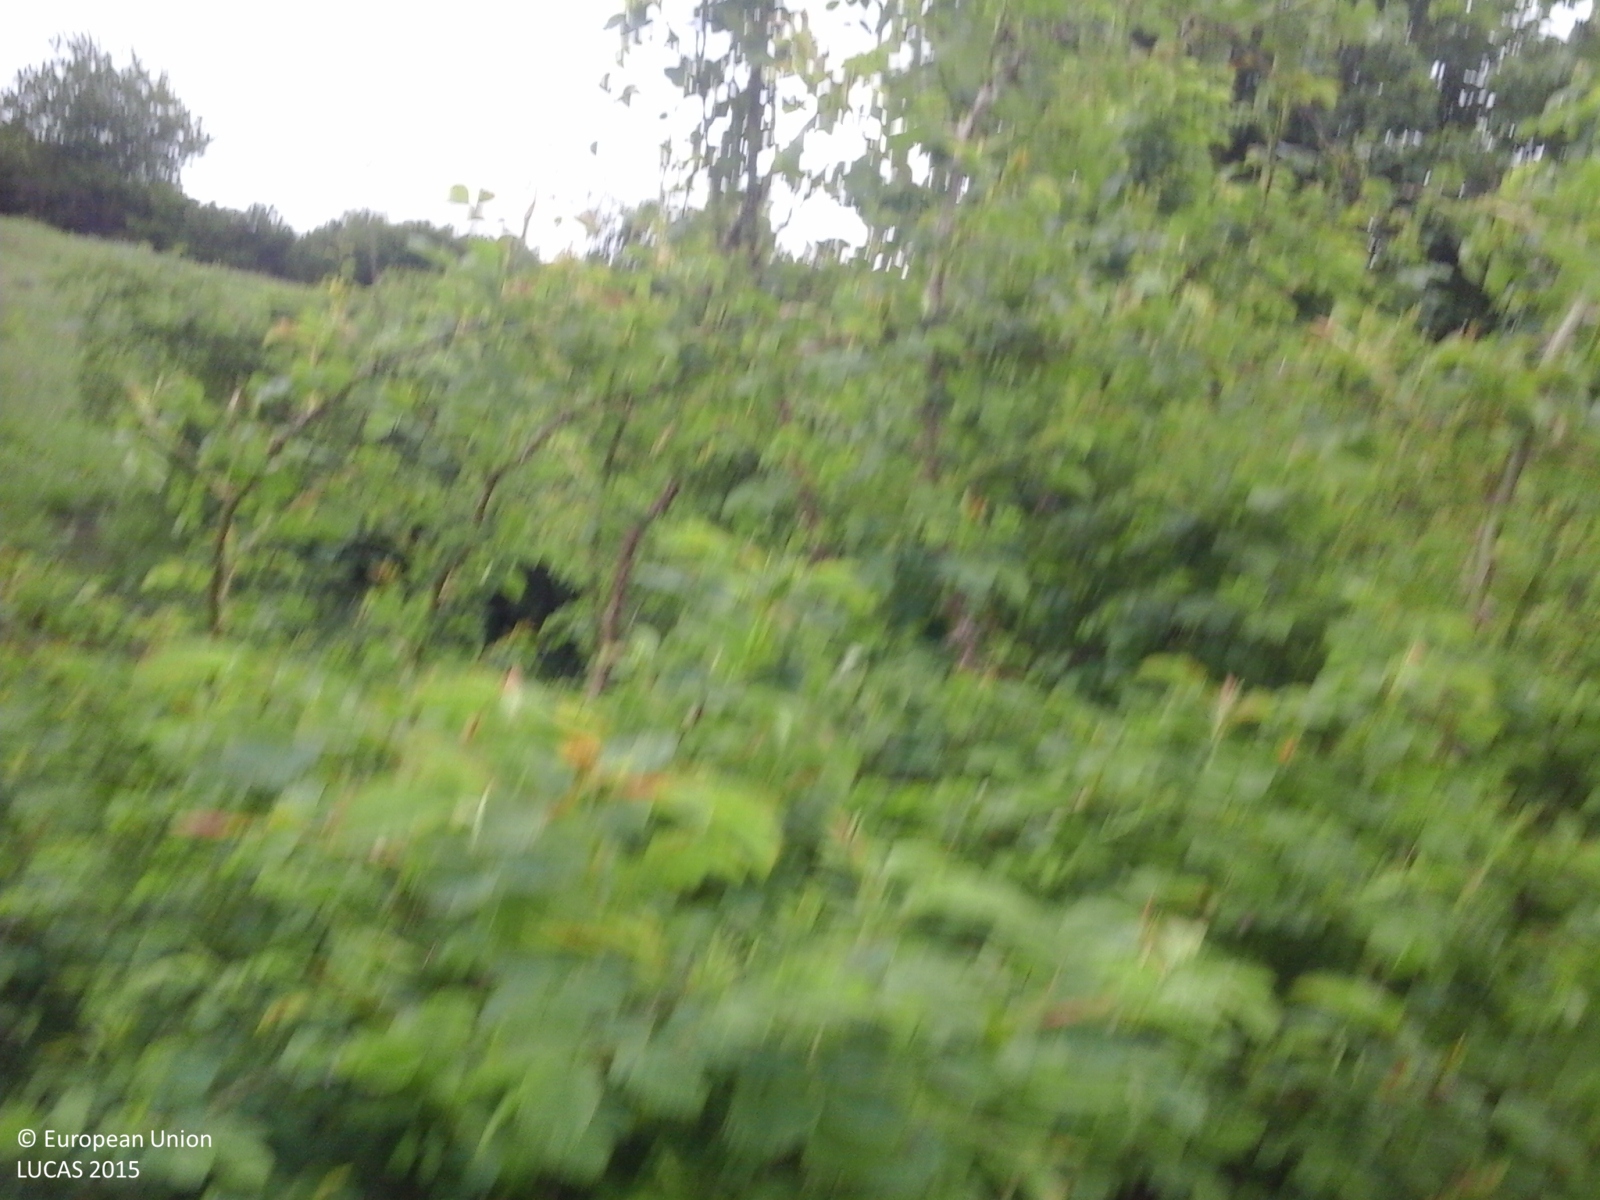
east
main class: Woodland
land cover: Broadleaved woodland
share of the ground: > 75 %
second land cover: Grassland without tree/shrub cover
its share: > 75 %
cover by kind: broadleaved forest trees 45 %, herbaceous plants 45 %, shrubs 10 %
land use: Forestry
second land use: Agriculture (excluding fallow land and kitchen gardens)
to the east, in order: Broadleaved woodland; Grassland without tree/shrub cover; Fences; Broadleaved woodland; Grassland without tree/shrub cover; Broadleaved woodland; Shrubland with sparse tree cover; Grassland without tree/shrub cover; Fences; Shrubland with sparse tree cover; Other bare soil
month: May
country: IT
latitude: 45.6622
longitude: 10.9610
